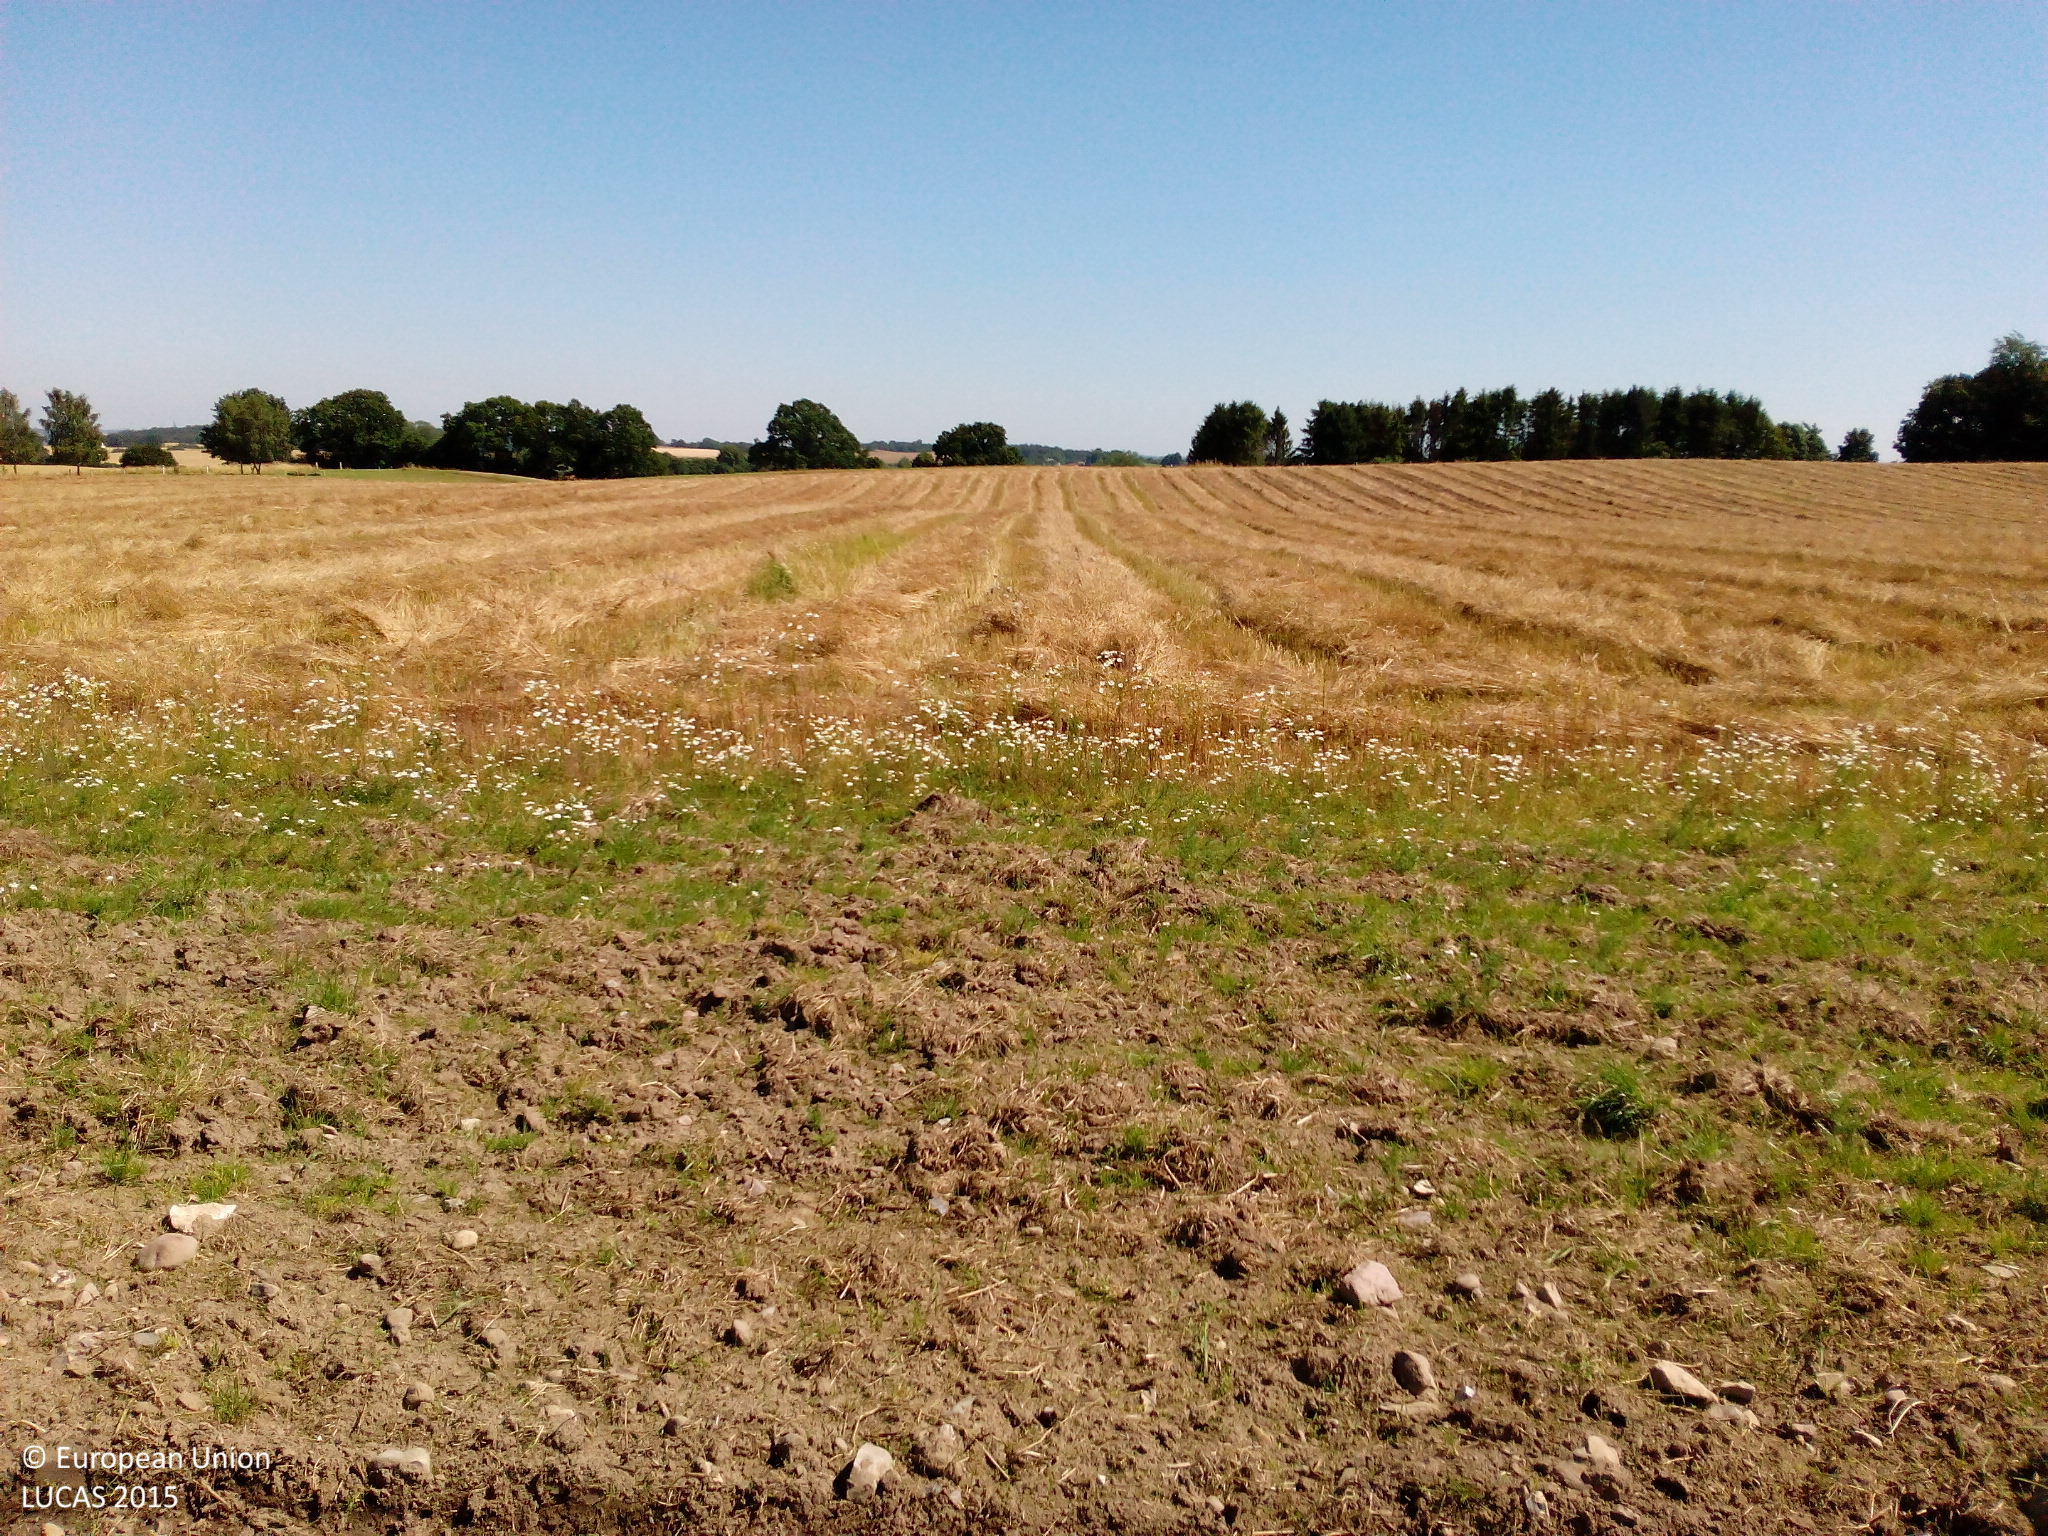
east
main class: Cropland
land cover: Rye
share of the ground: > 75 %
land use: Agriculture (excluding fallow land and kitchen gardens)
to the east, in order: Rye; Grassland without tree/shrub cover; Temporary grasslands; Barley; Fences; Grassland without tree/shrub cover
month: August
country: DK
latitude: 55.5806
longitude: 11.8861
